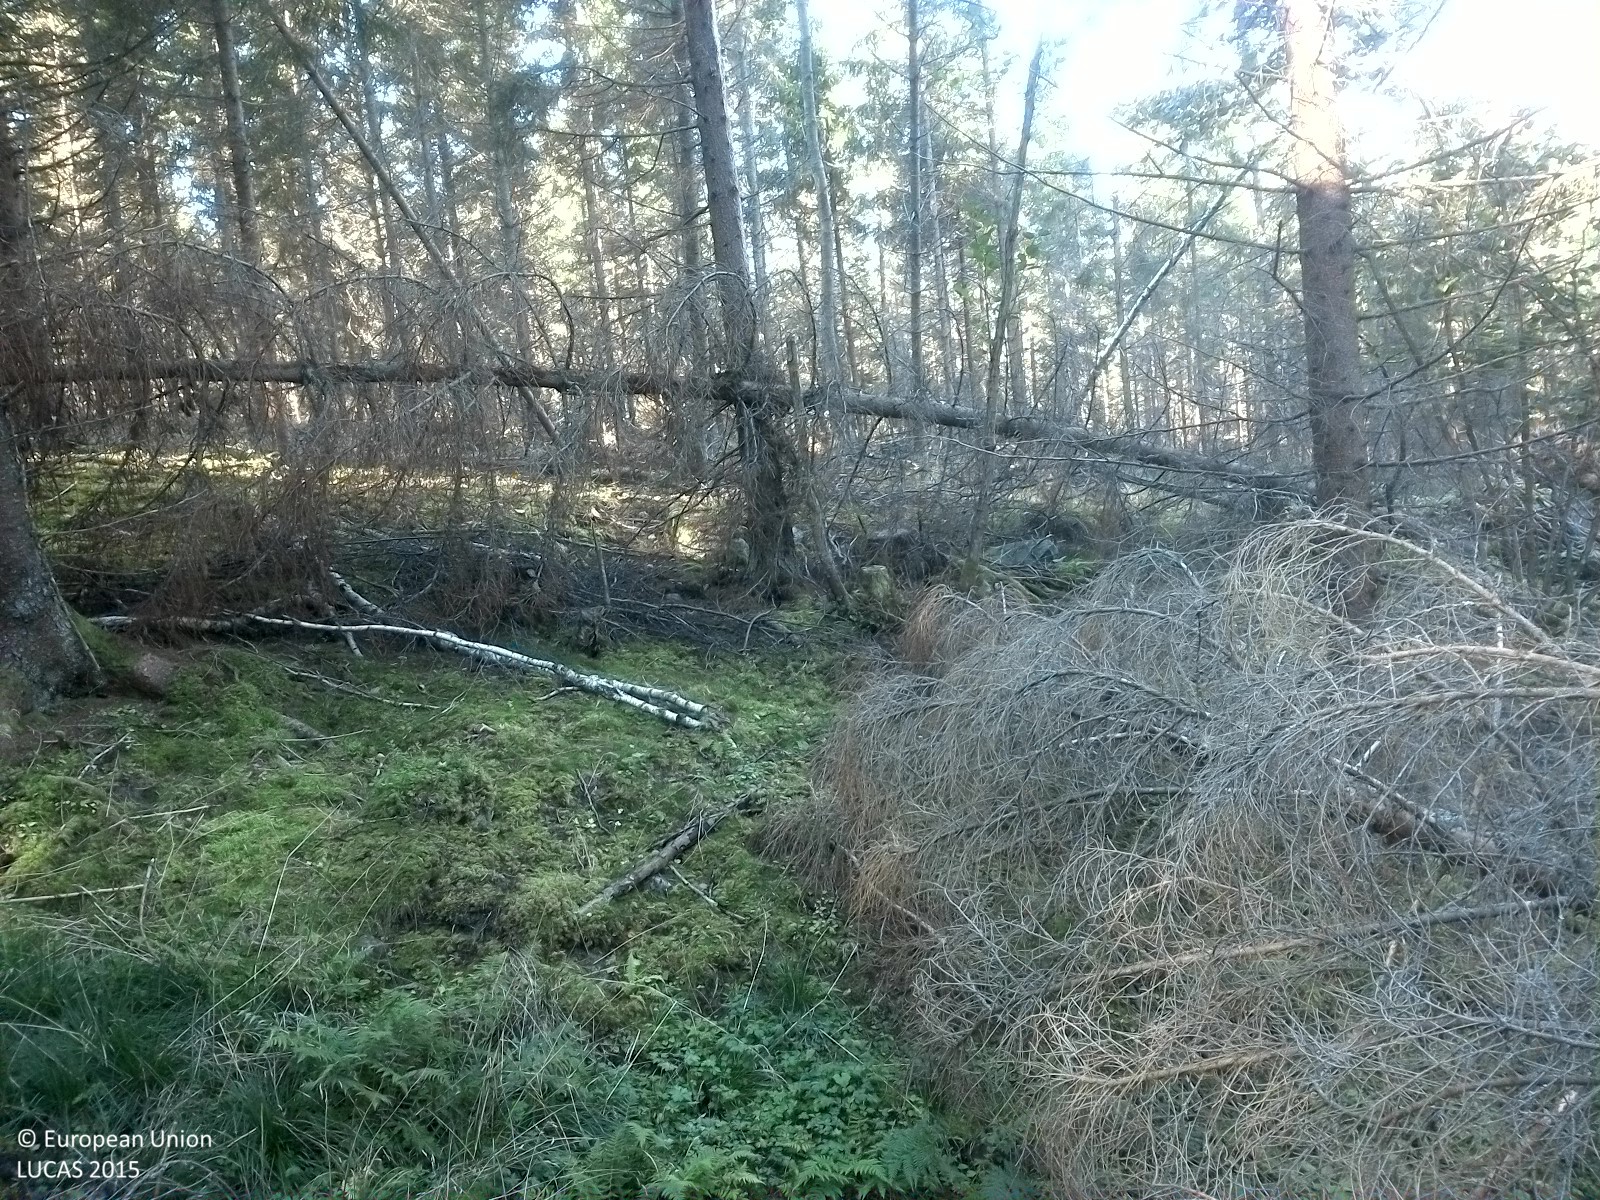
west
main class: Woodland
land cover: Spruce dominated coniferous woodland
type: boreal forest
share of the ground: 25 - 50 %
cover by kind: lichens and mosses 40 %, coniferous forest trees 30 %, herbaceous plants 30 %
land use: Forestry
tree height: > 5 m
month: September
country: SE
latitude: 58.7345
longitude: 16.7850
